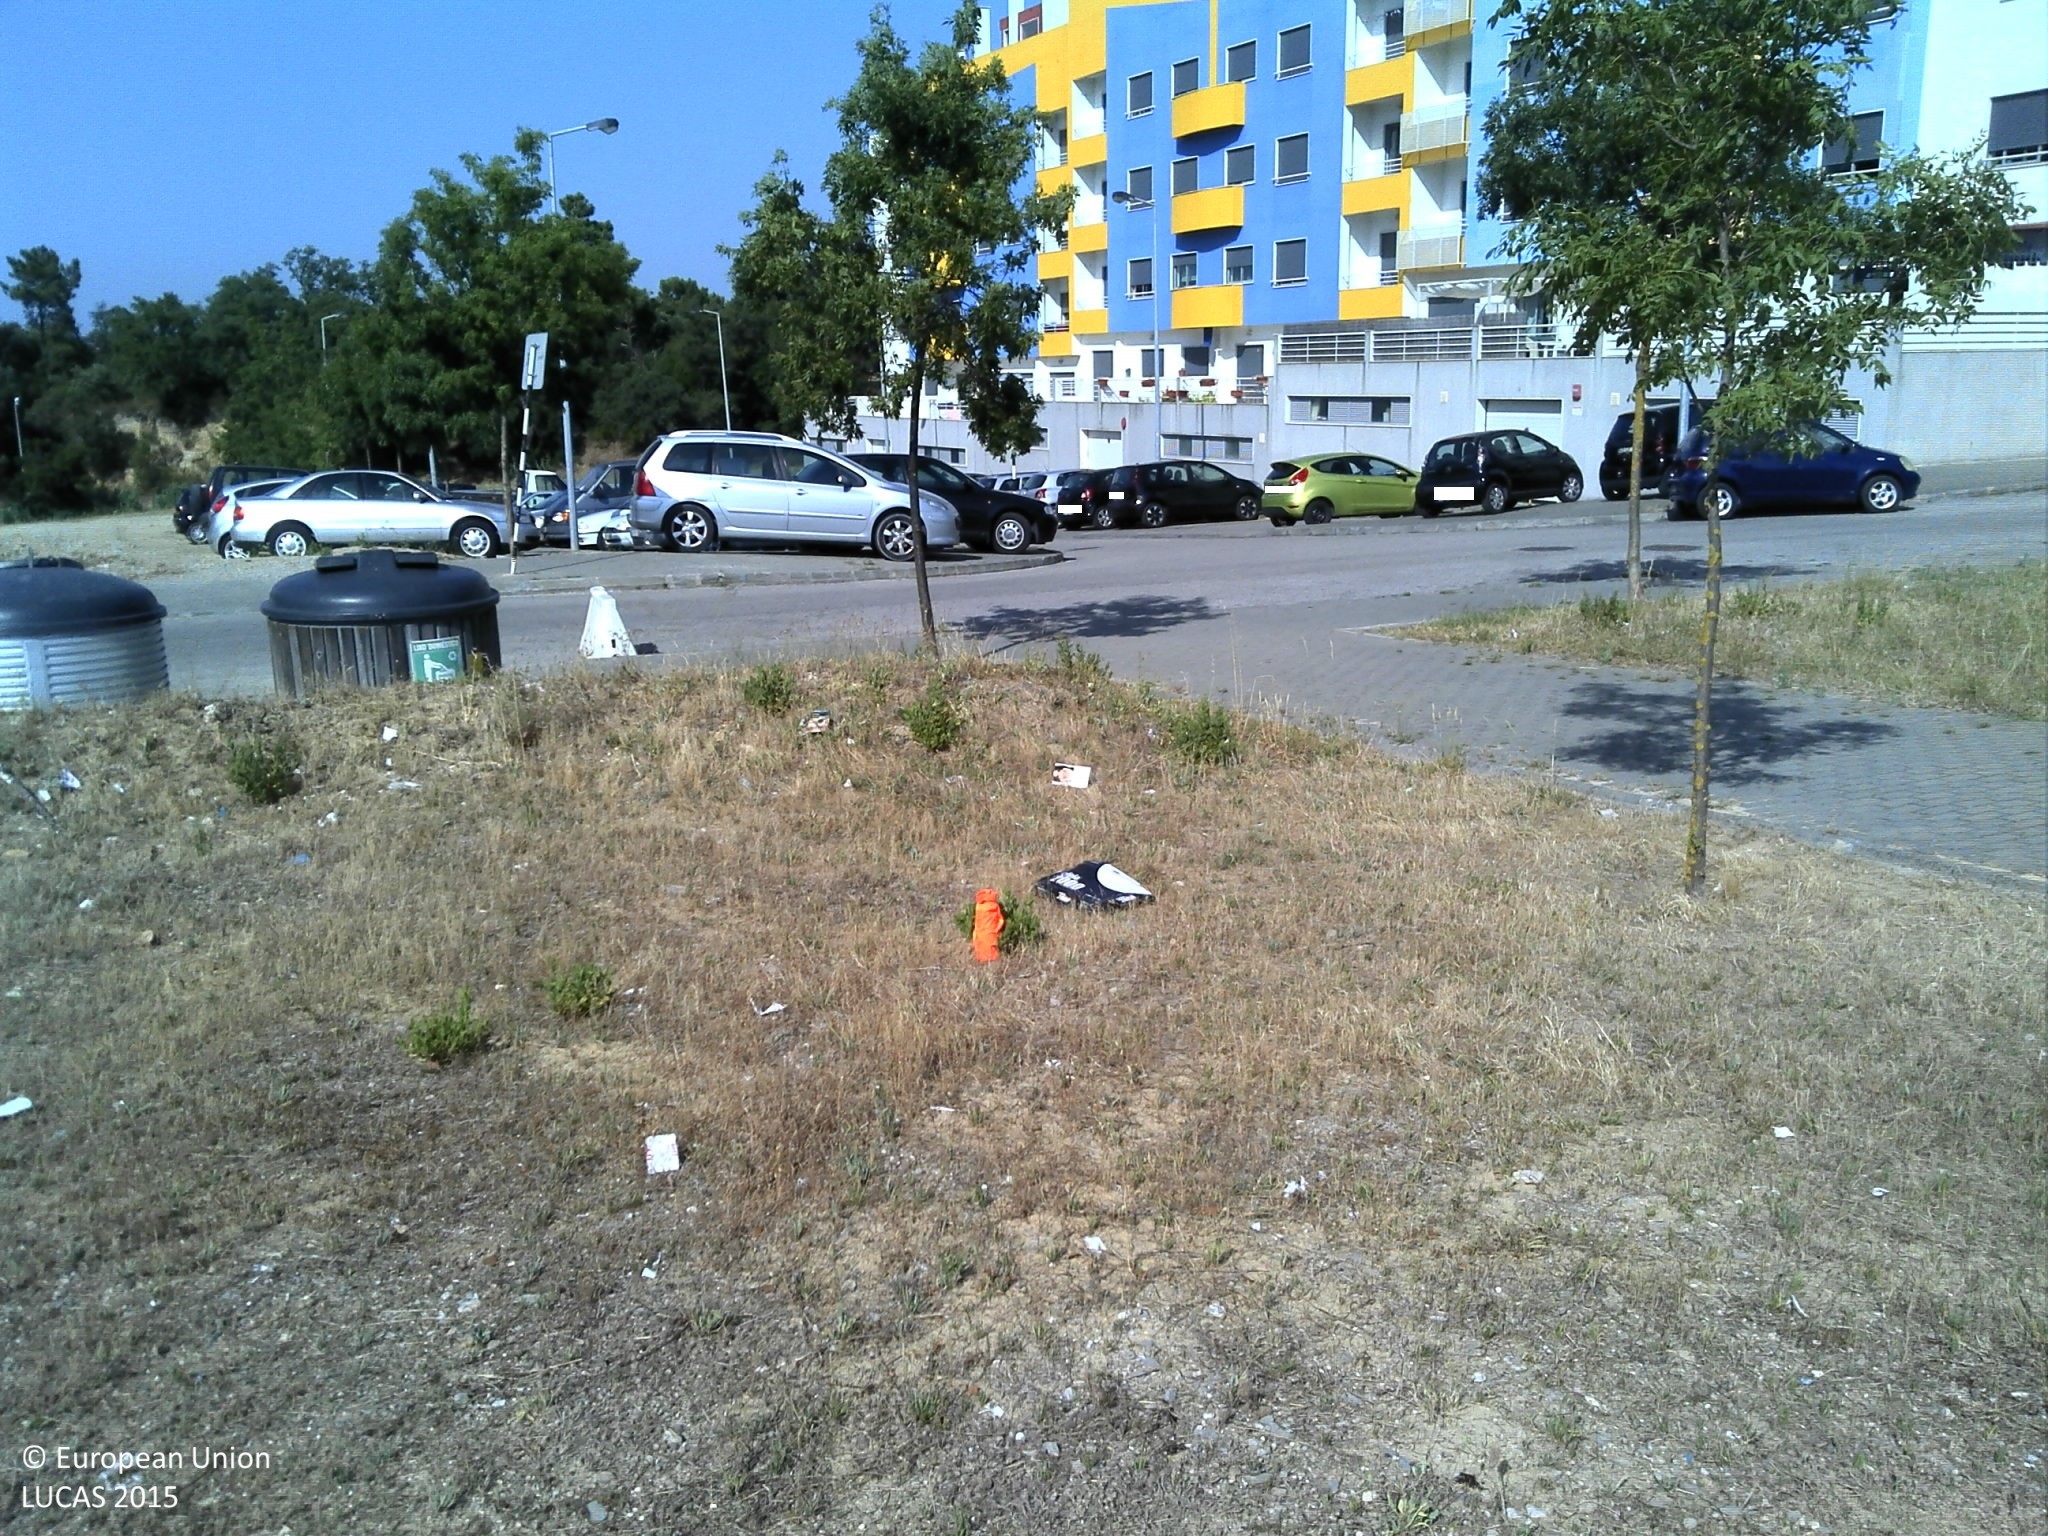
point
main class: Grassland
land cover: Grassland with sparse tree/shrub cover
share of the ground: 25 - 50 %
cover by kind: herbaceous plants 40 %, unconsolidated bare surface 35 %, broadleaved forest trees 5 %
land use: Residential
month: June
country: PT
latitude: 38.6117
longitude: -9.1011
